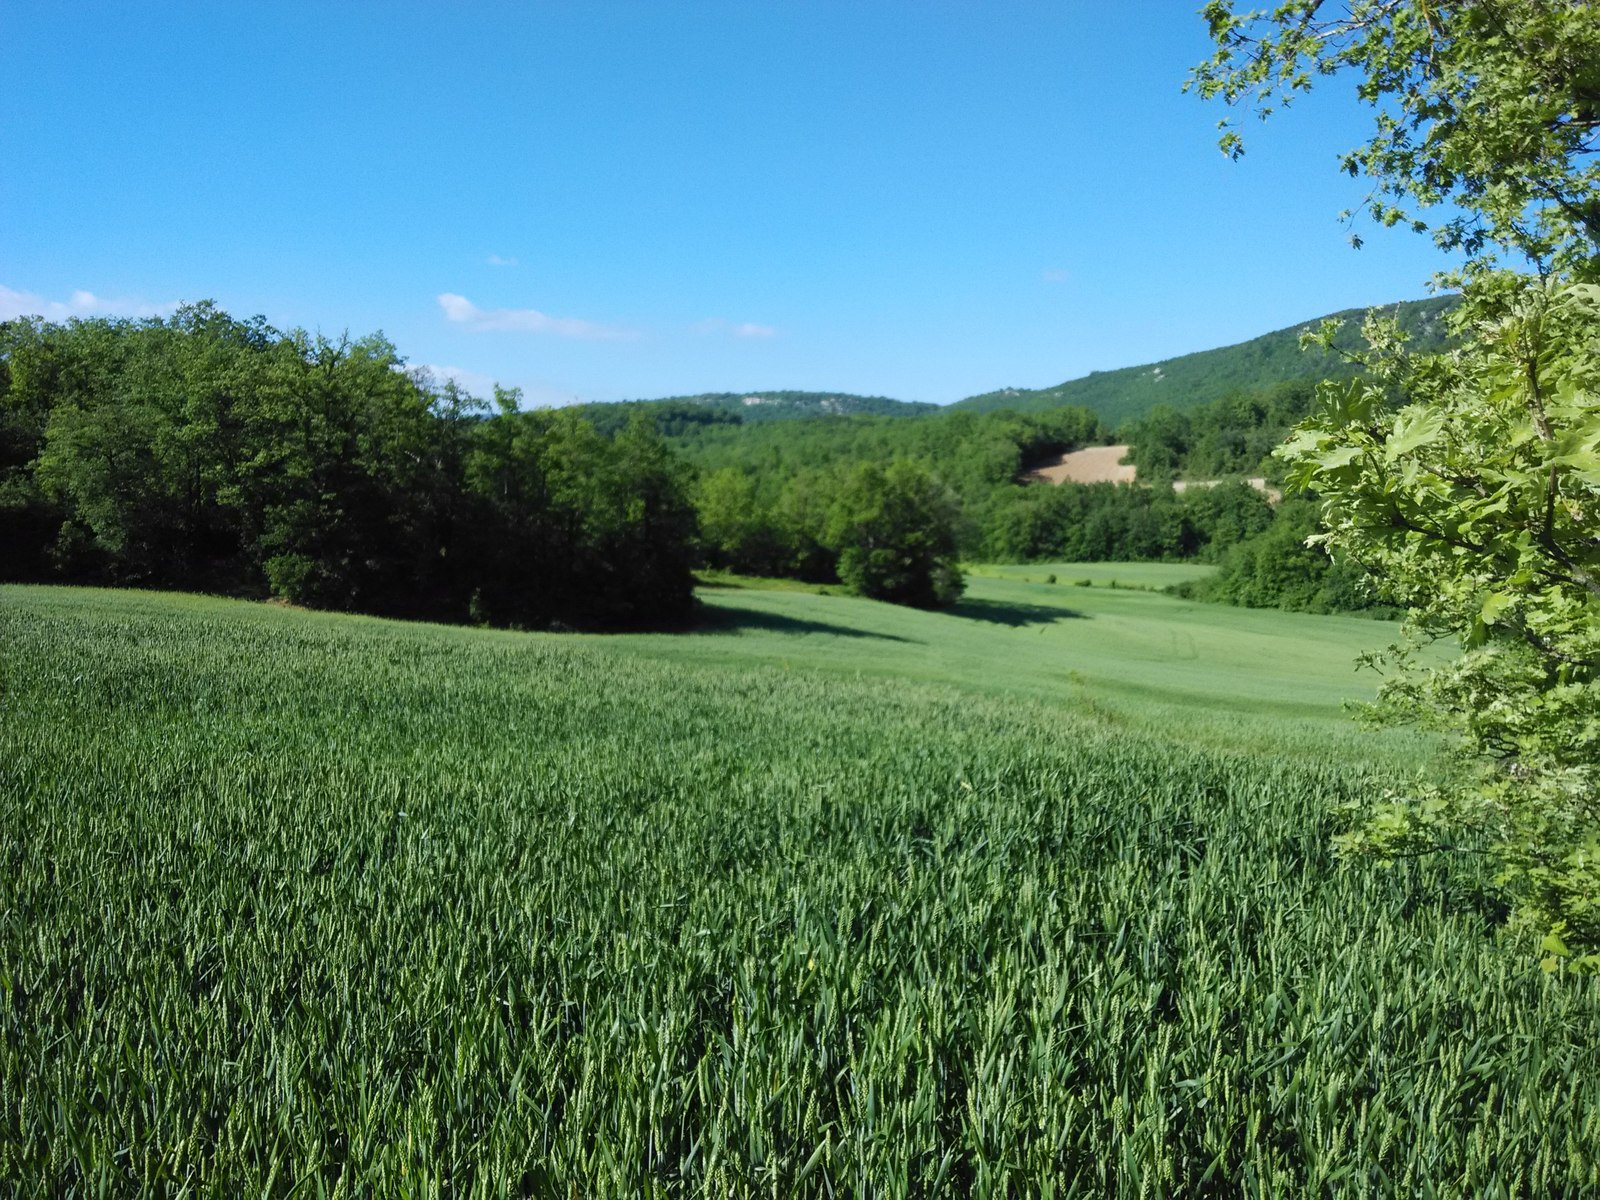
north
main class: Cropland
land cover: Common wheat
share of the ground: > 75 %
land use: Agriculture (excluding fallow land and kitchen gardens)
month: May
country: ES
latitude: 42.7230
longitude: -2.4424
